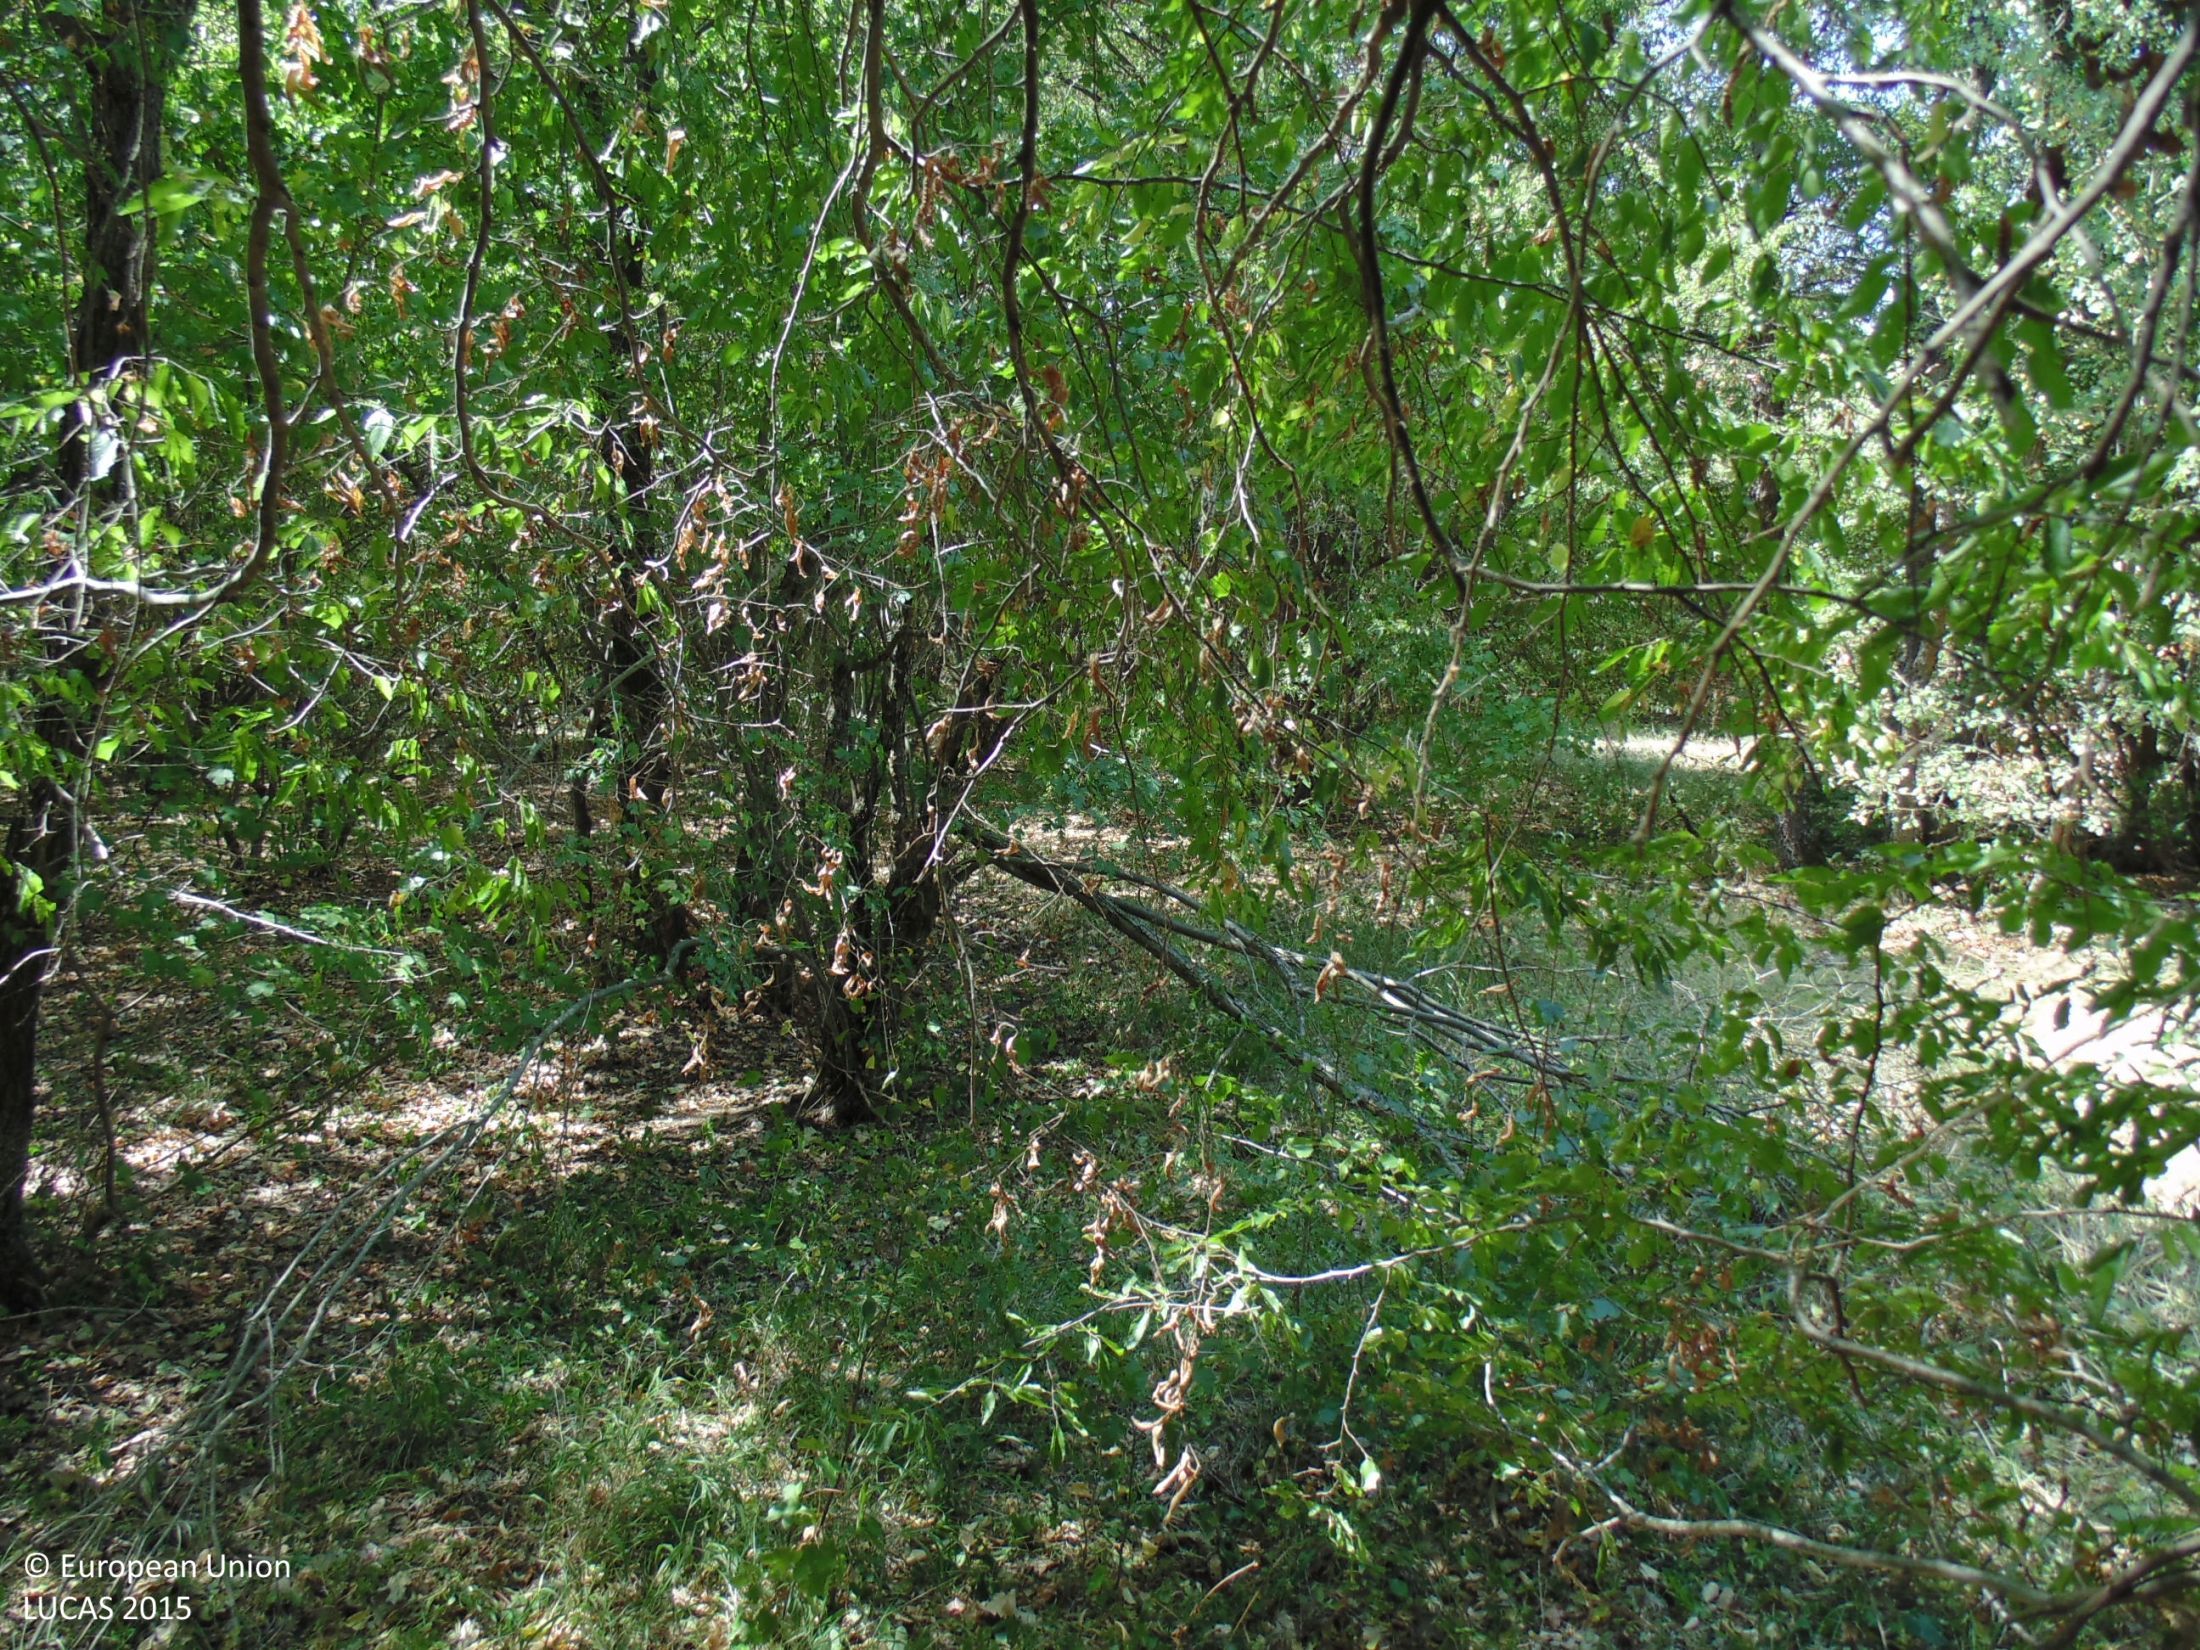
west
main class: Woodland
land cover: Broadleaved woodland
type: mesophytic deciduous forest
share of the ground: > 75 %
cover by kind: broadleaved forest trees 90 %, shrubs 5 %, unconsolidated bare surface 5 %
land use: Forestry
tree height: > 5 m
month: August
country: BG
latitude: 43.7204
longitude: 27.5758
